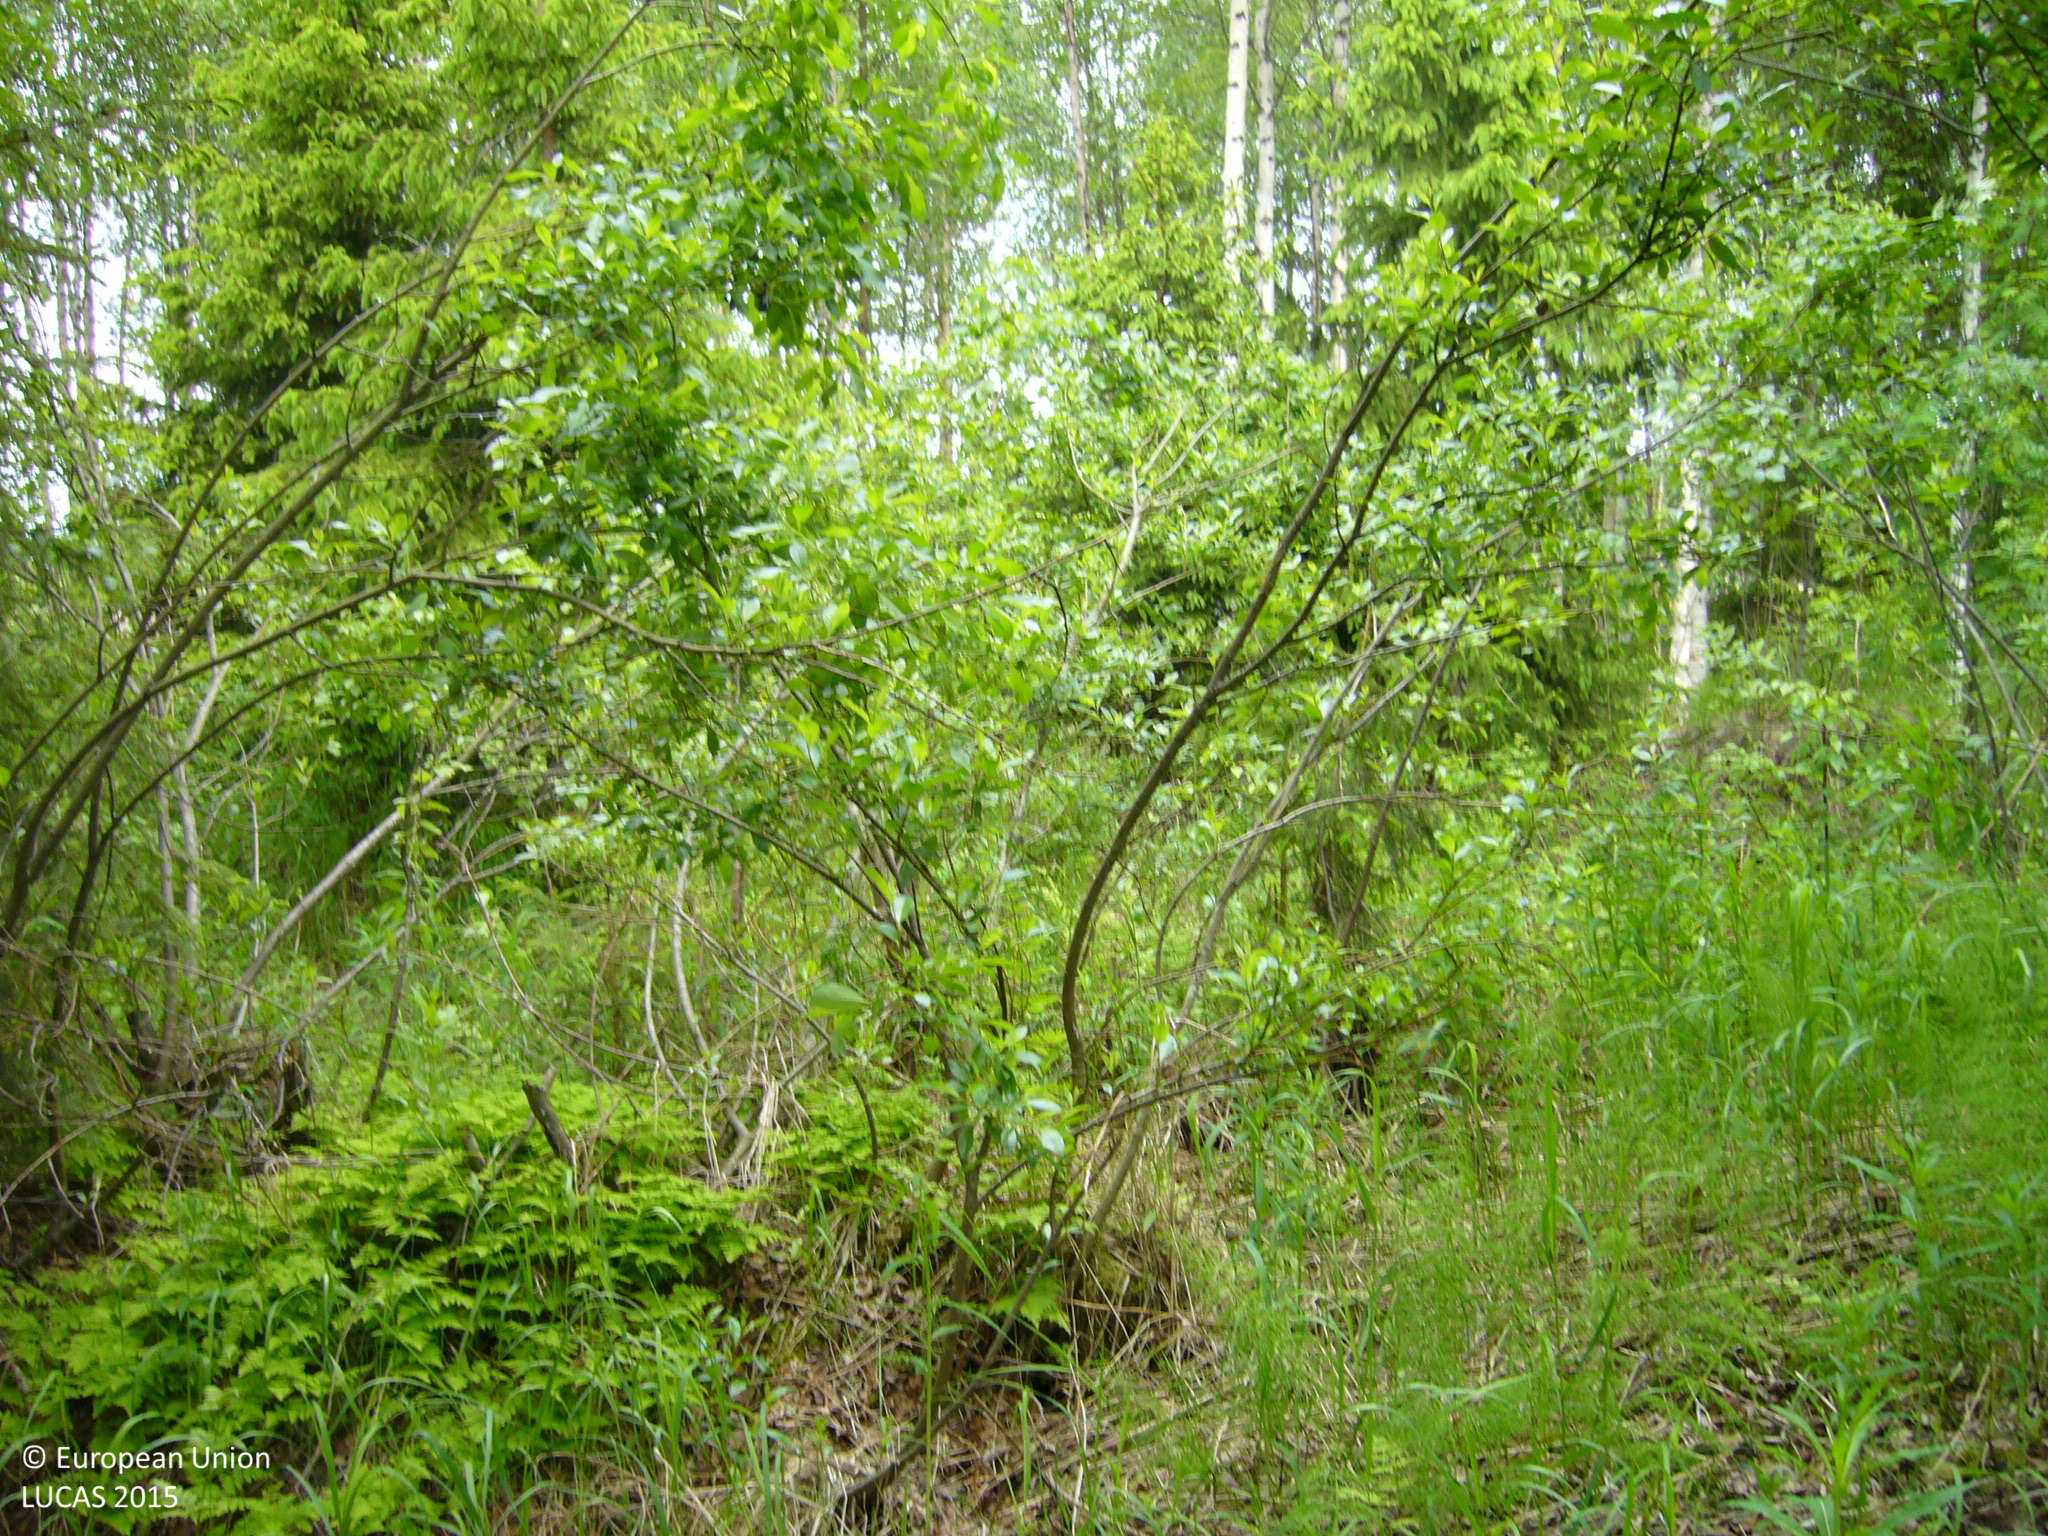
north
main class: Woodland
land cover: Spruce dominated mixed woodland
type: boreal forest
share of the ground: > 75 %
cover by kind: coniferous forest trees 50 %, broadleaved forest trees 40 %, shrubs 10 %
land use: Forestry
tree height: > 5 m
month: June
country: FI
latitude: 63.5463
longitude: 26.8147
